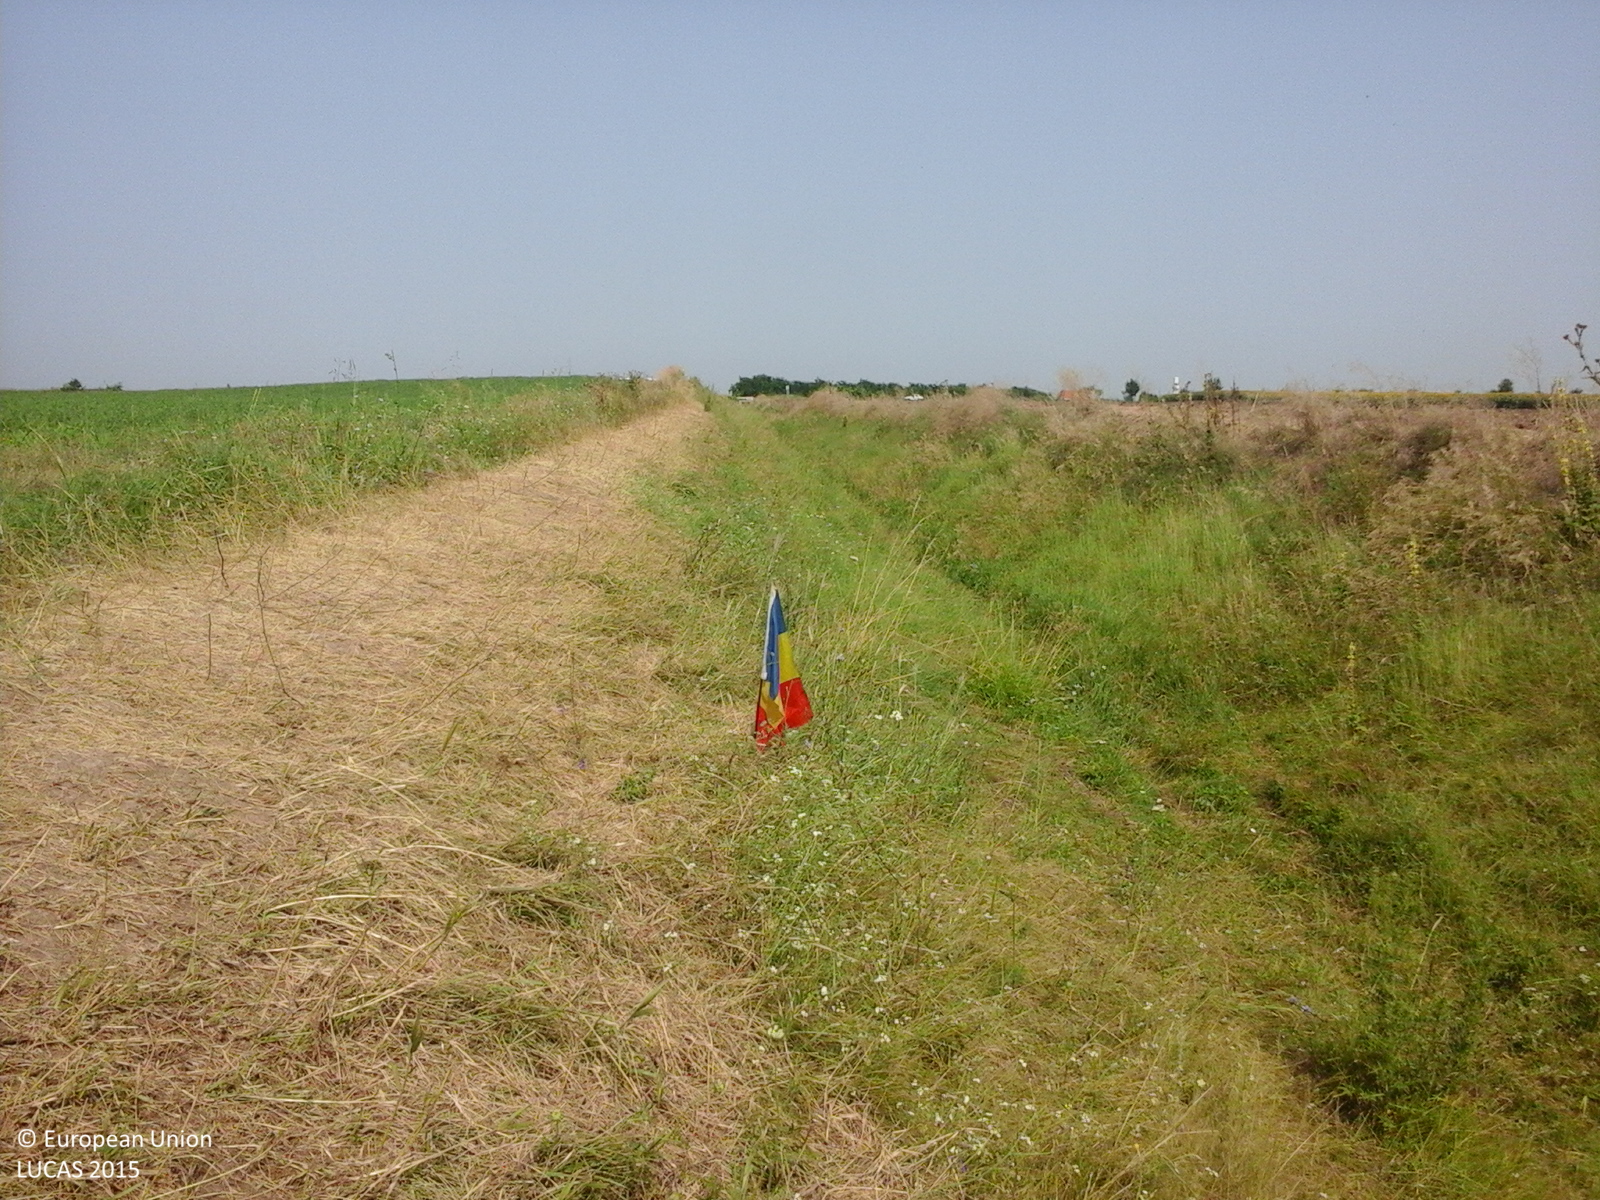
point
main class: Grassland
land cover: Spontaneously vegetated surfaces
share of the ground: > 75 %
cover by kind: herbaceous plants 100 %
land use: Fallow land
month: July
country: RO
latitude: 44.8099
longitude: 26.6746
